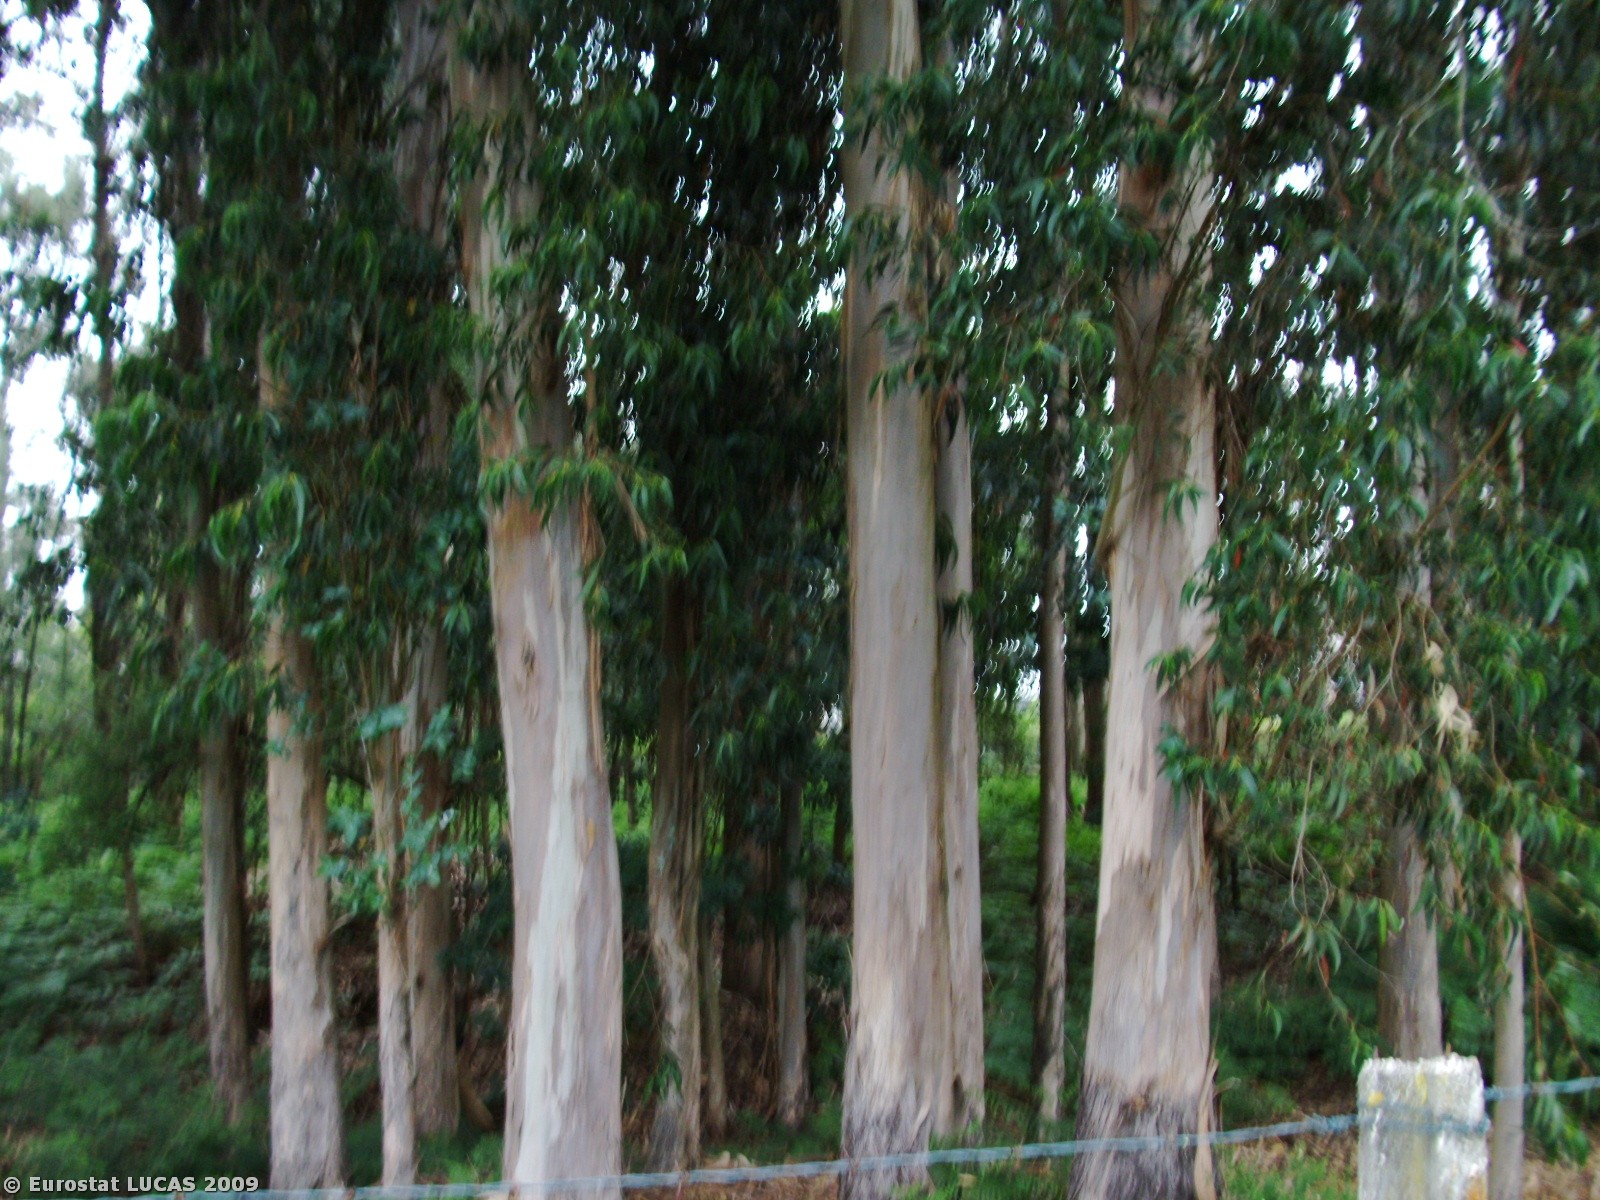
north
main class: Woodland
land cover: Broadleaved woodland
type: plantations and self-sown exotic forest
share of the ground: > 75 %
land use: Forestry
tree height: > 5 m
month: May
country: PT
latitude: 41.0904
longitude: -8.5424
